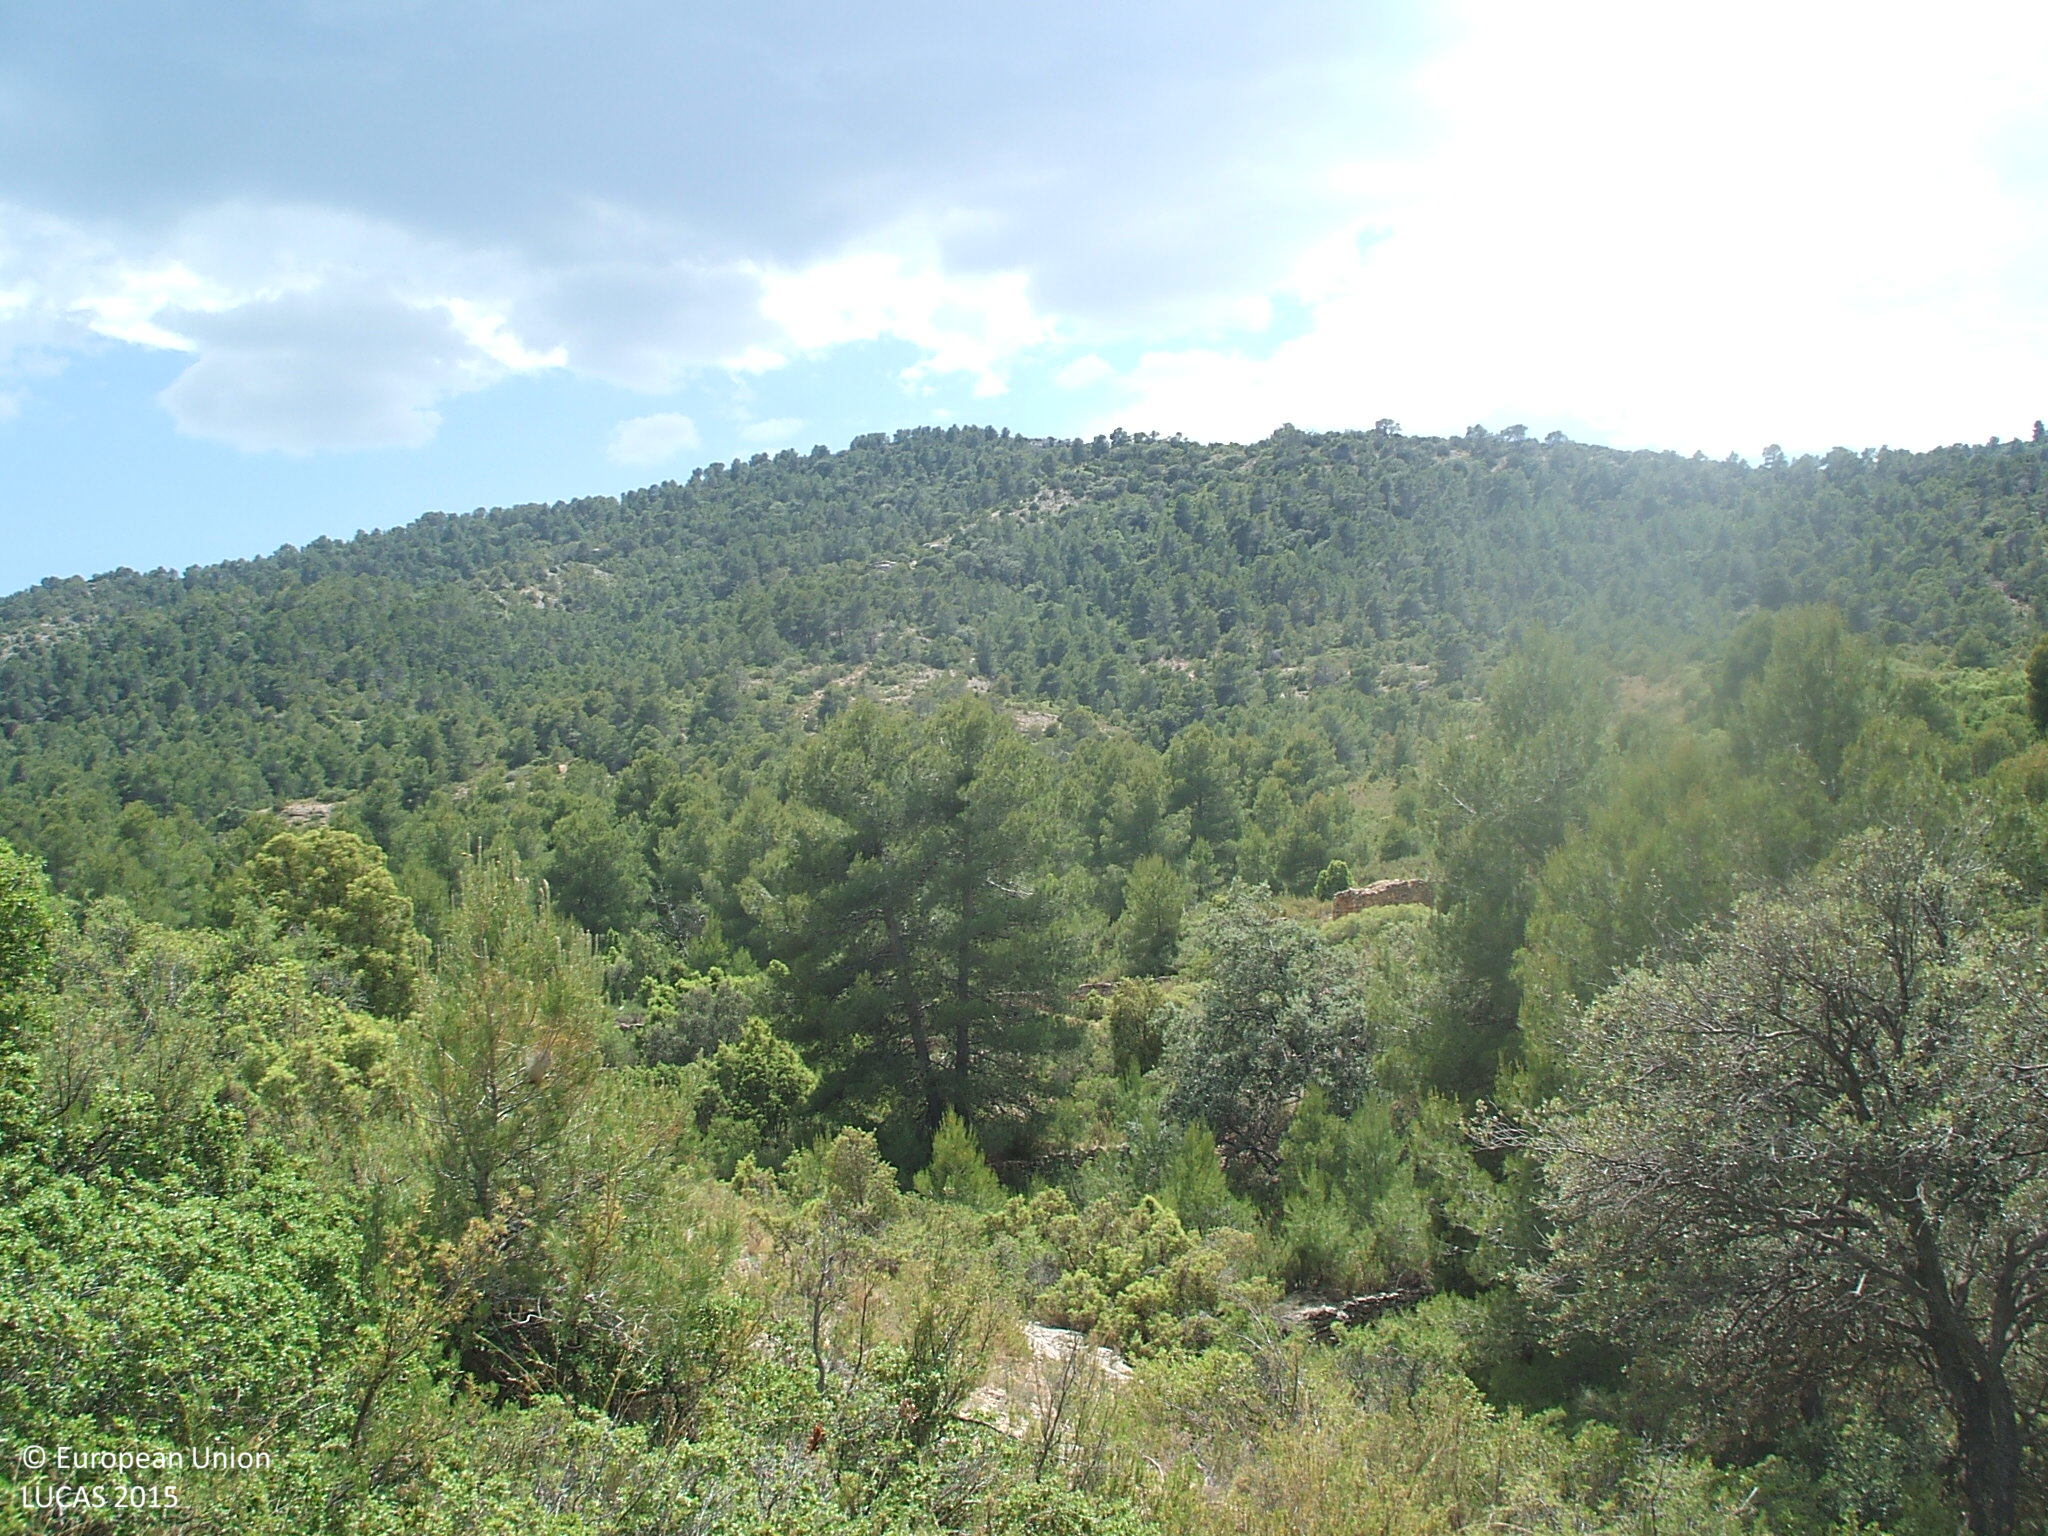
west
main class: Shrubland
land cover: Shrubland with sparse tree cover
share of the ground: 25 - 50 %
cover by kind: consolidated bare surface 75 %, shrubs 20 %, coniferous forest trees 5 %
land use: Semi-natural and natural areas not in use
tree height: < 5 m
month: June
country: ES
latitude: 40.8913
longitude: -0.1104
